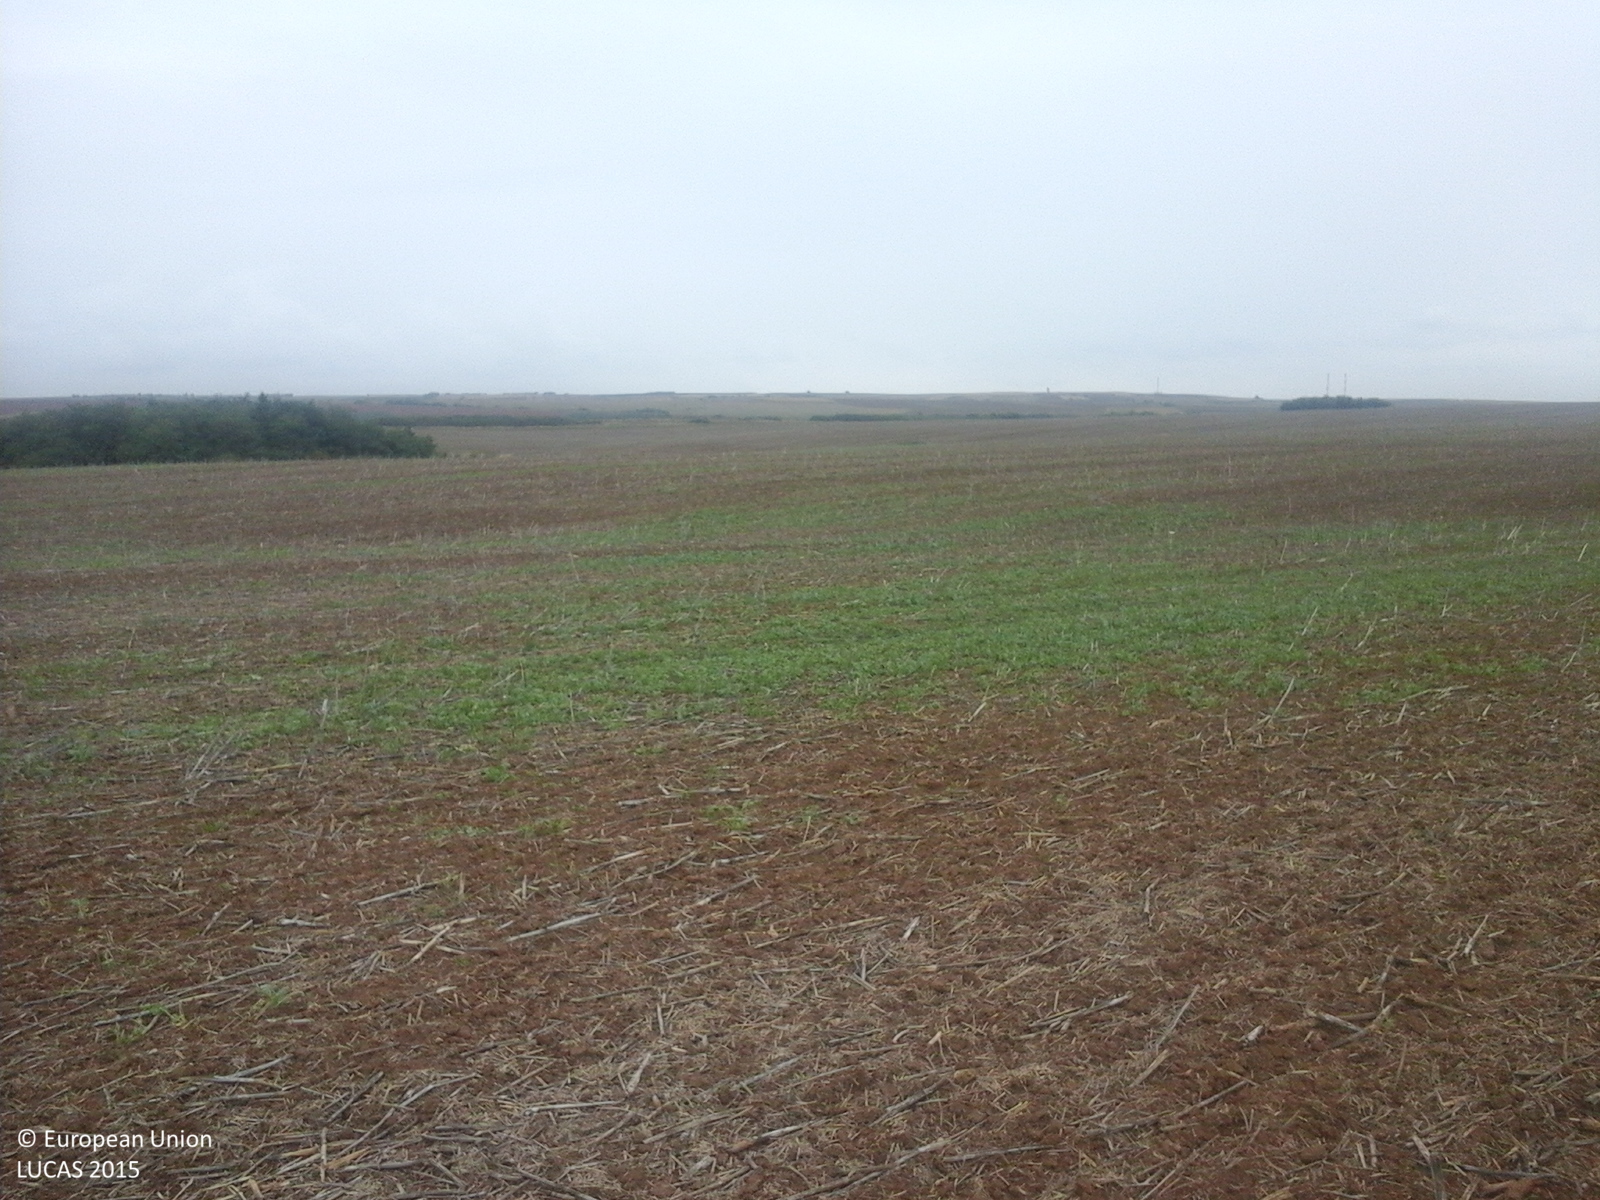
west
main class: Cropland
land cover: Rape and turnip rape
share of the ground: < 10 %
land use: Agriculture (excluding fallow land and kitchen gardens)
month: September
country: RO
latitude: 47.2849
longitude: 22.0677
